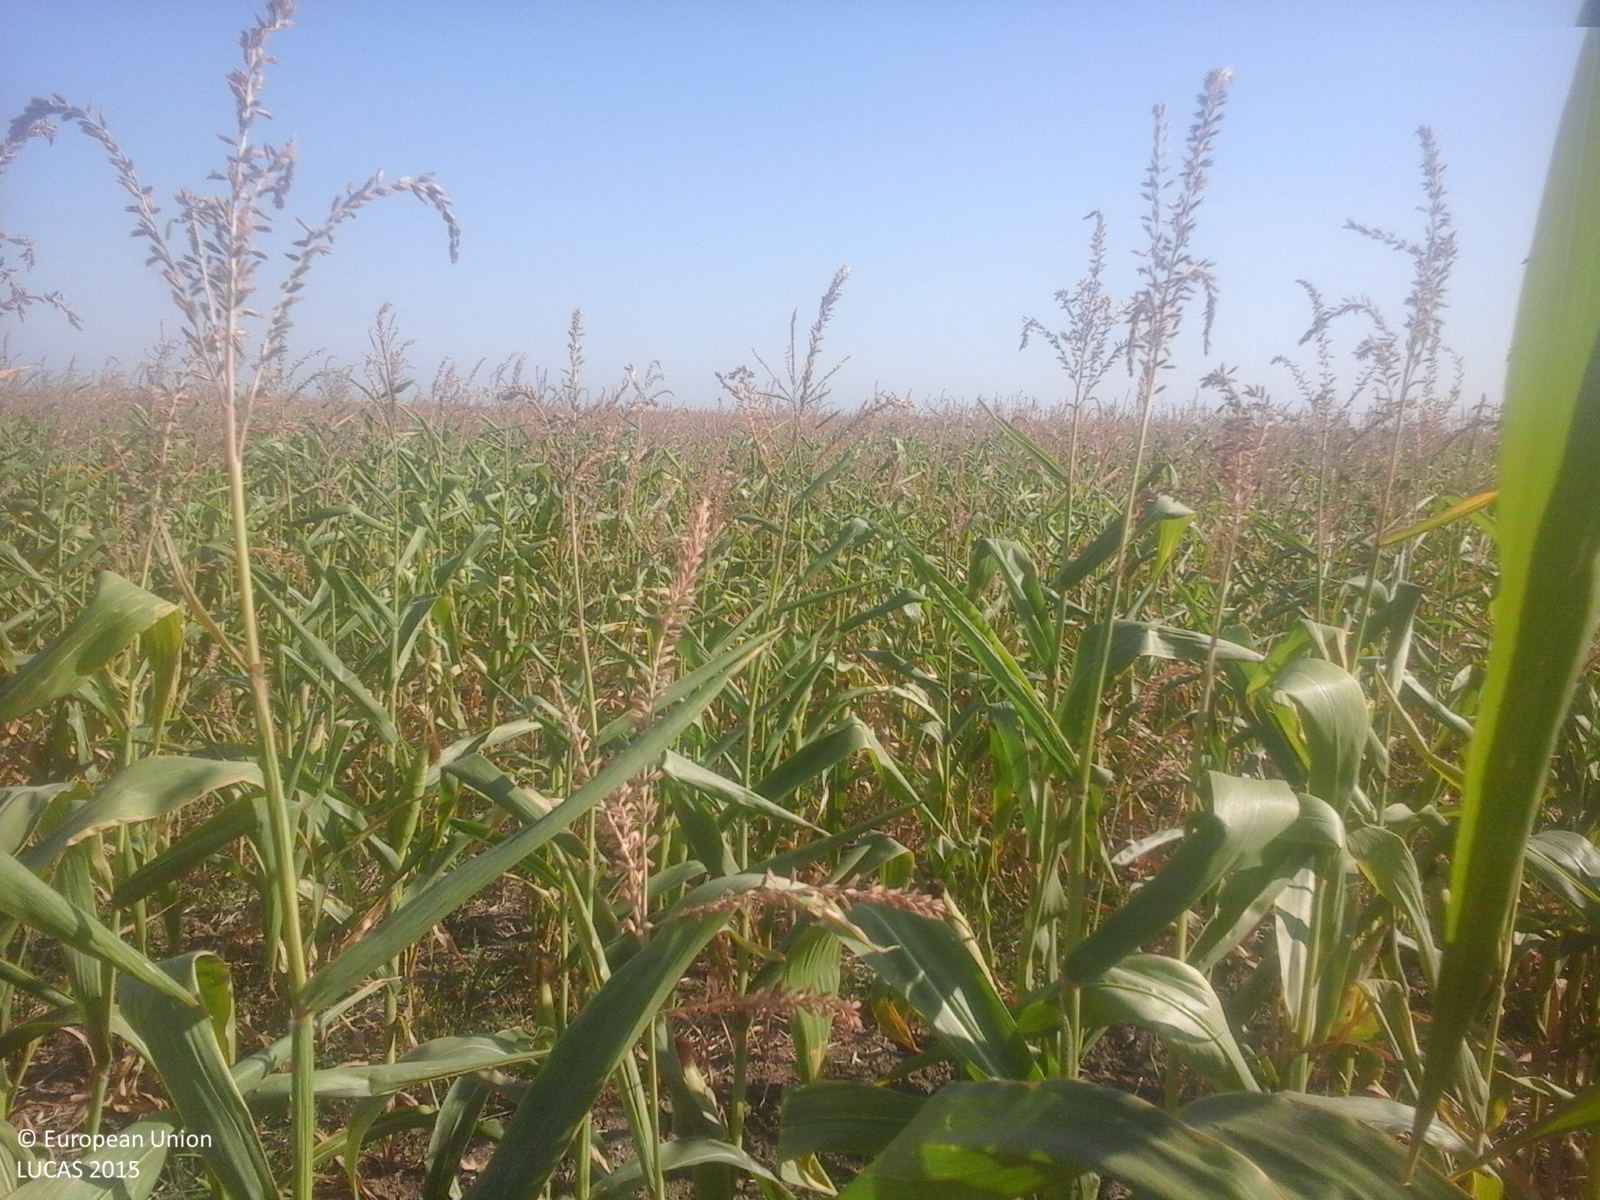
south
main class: Cropland
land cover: Maize
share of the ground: > 75 %
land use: Agriculture (excluding fallow land and kitchen gardens)
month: August
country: RO
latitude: 45.5974
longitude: 27.3675
